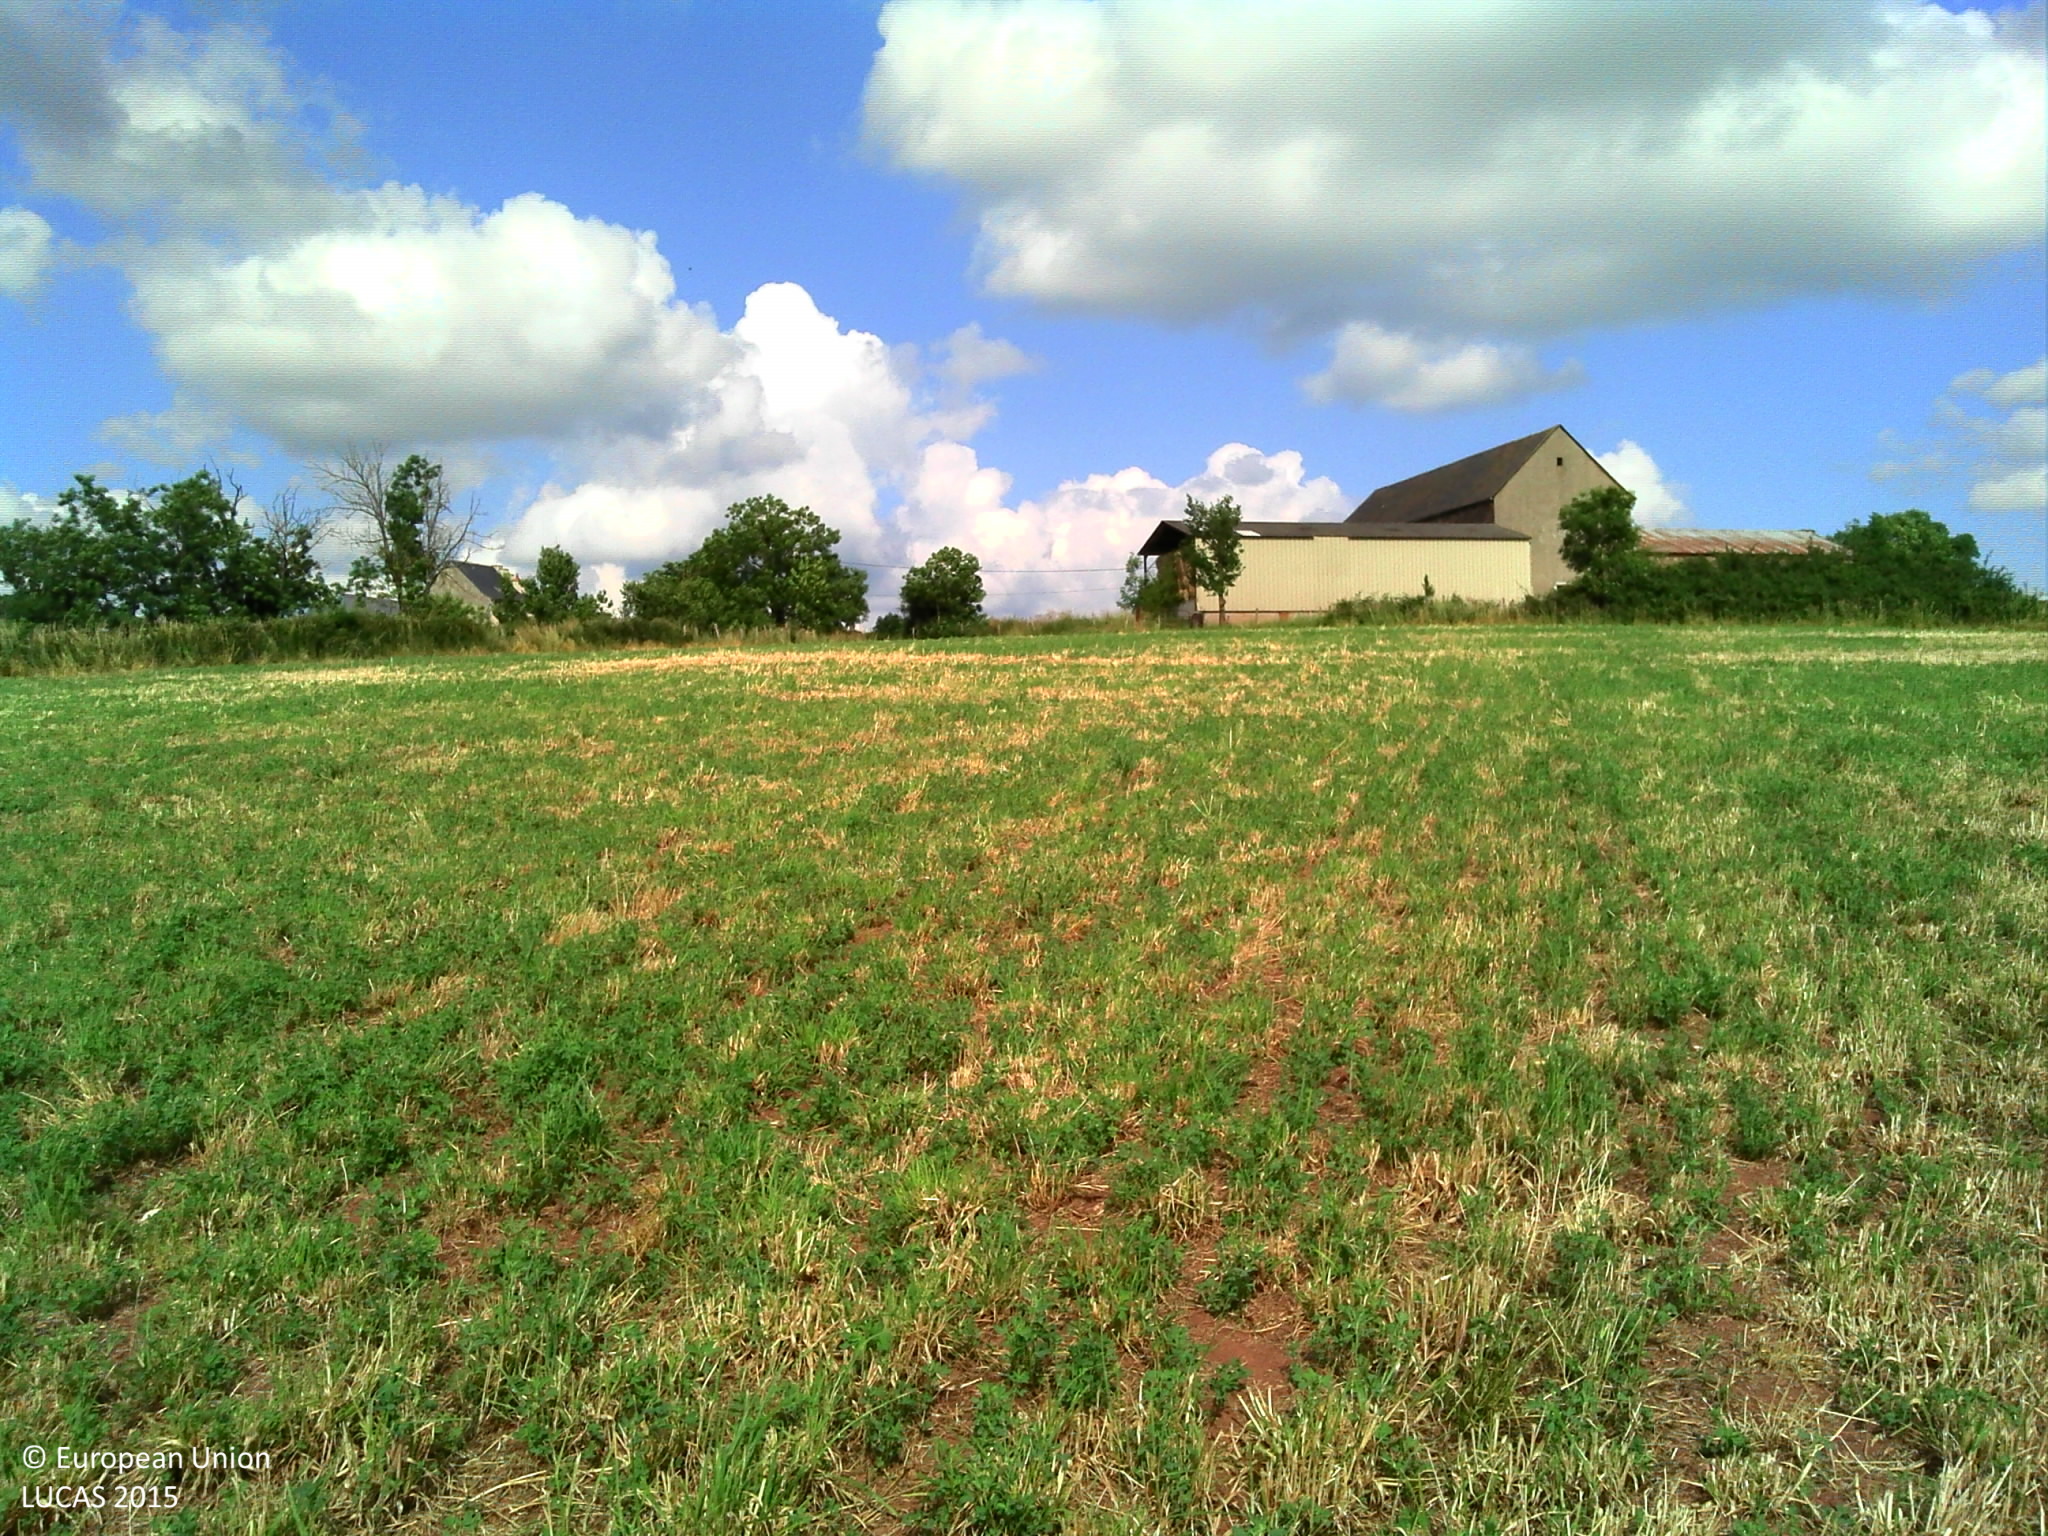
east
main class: Cropland
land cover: Lucerne
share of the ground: 50 - 75 %
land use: Agriculture (excluding fallow land and kitchen gardens)
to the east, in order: Lucerne; Fences; Grassland with sparse tree/shrub cover; Paved roads, cycling and walking lanes; Electric lines; Paved roads, cycling and walking lanes; Ditches and canals; Managed hedges; Electric lines; Grassland without tree/shrub cover; Fences; Managed hedges; Electric lines; Grassland without tree/shrub cover
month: June
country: FR
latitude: 44.3372
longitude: 2.5659
